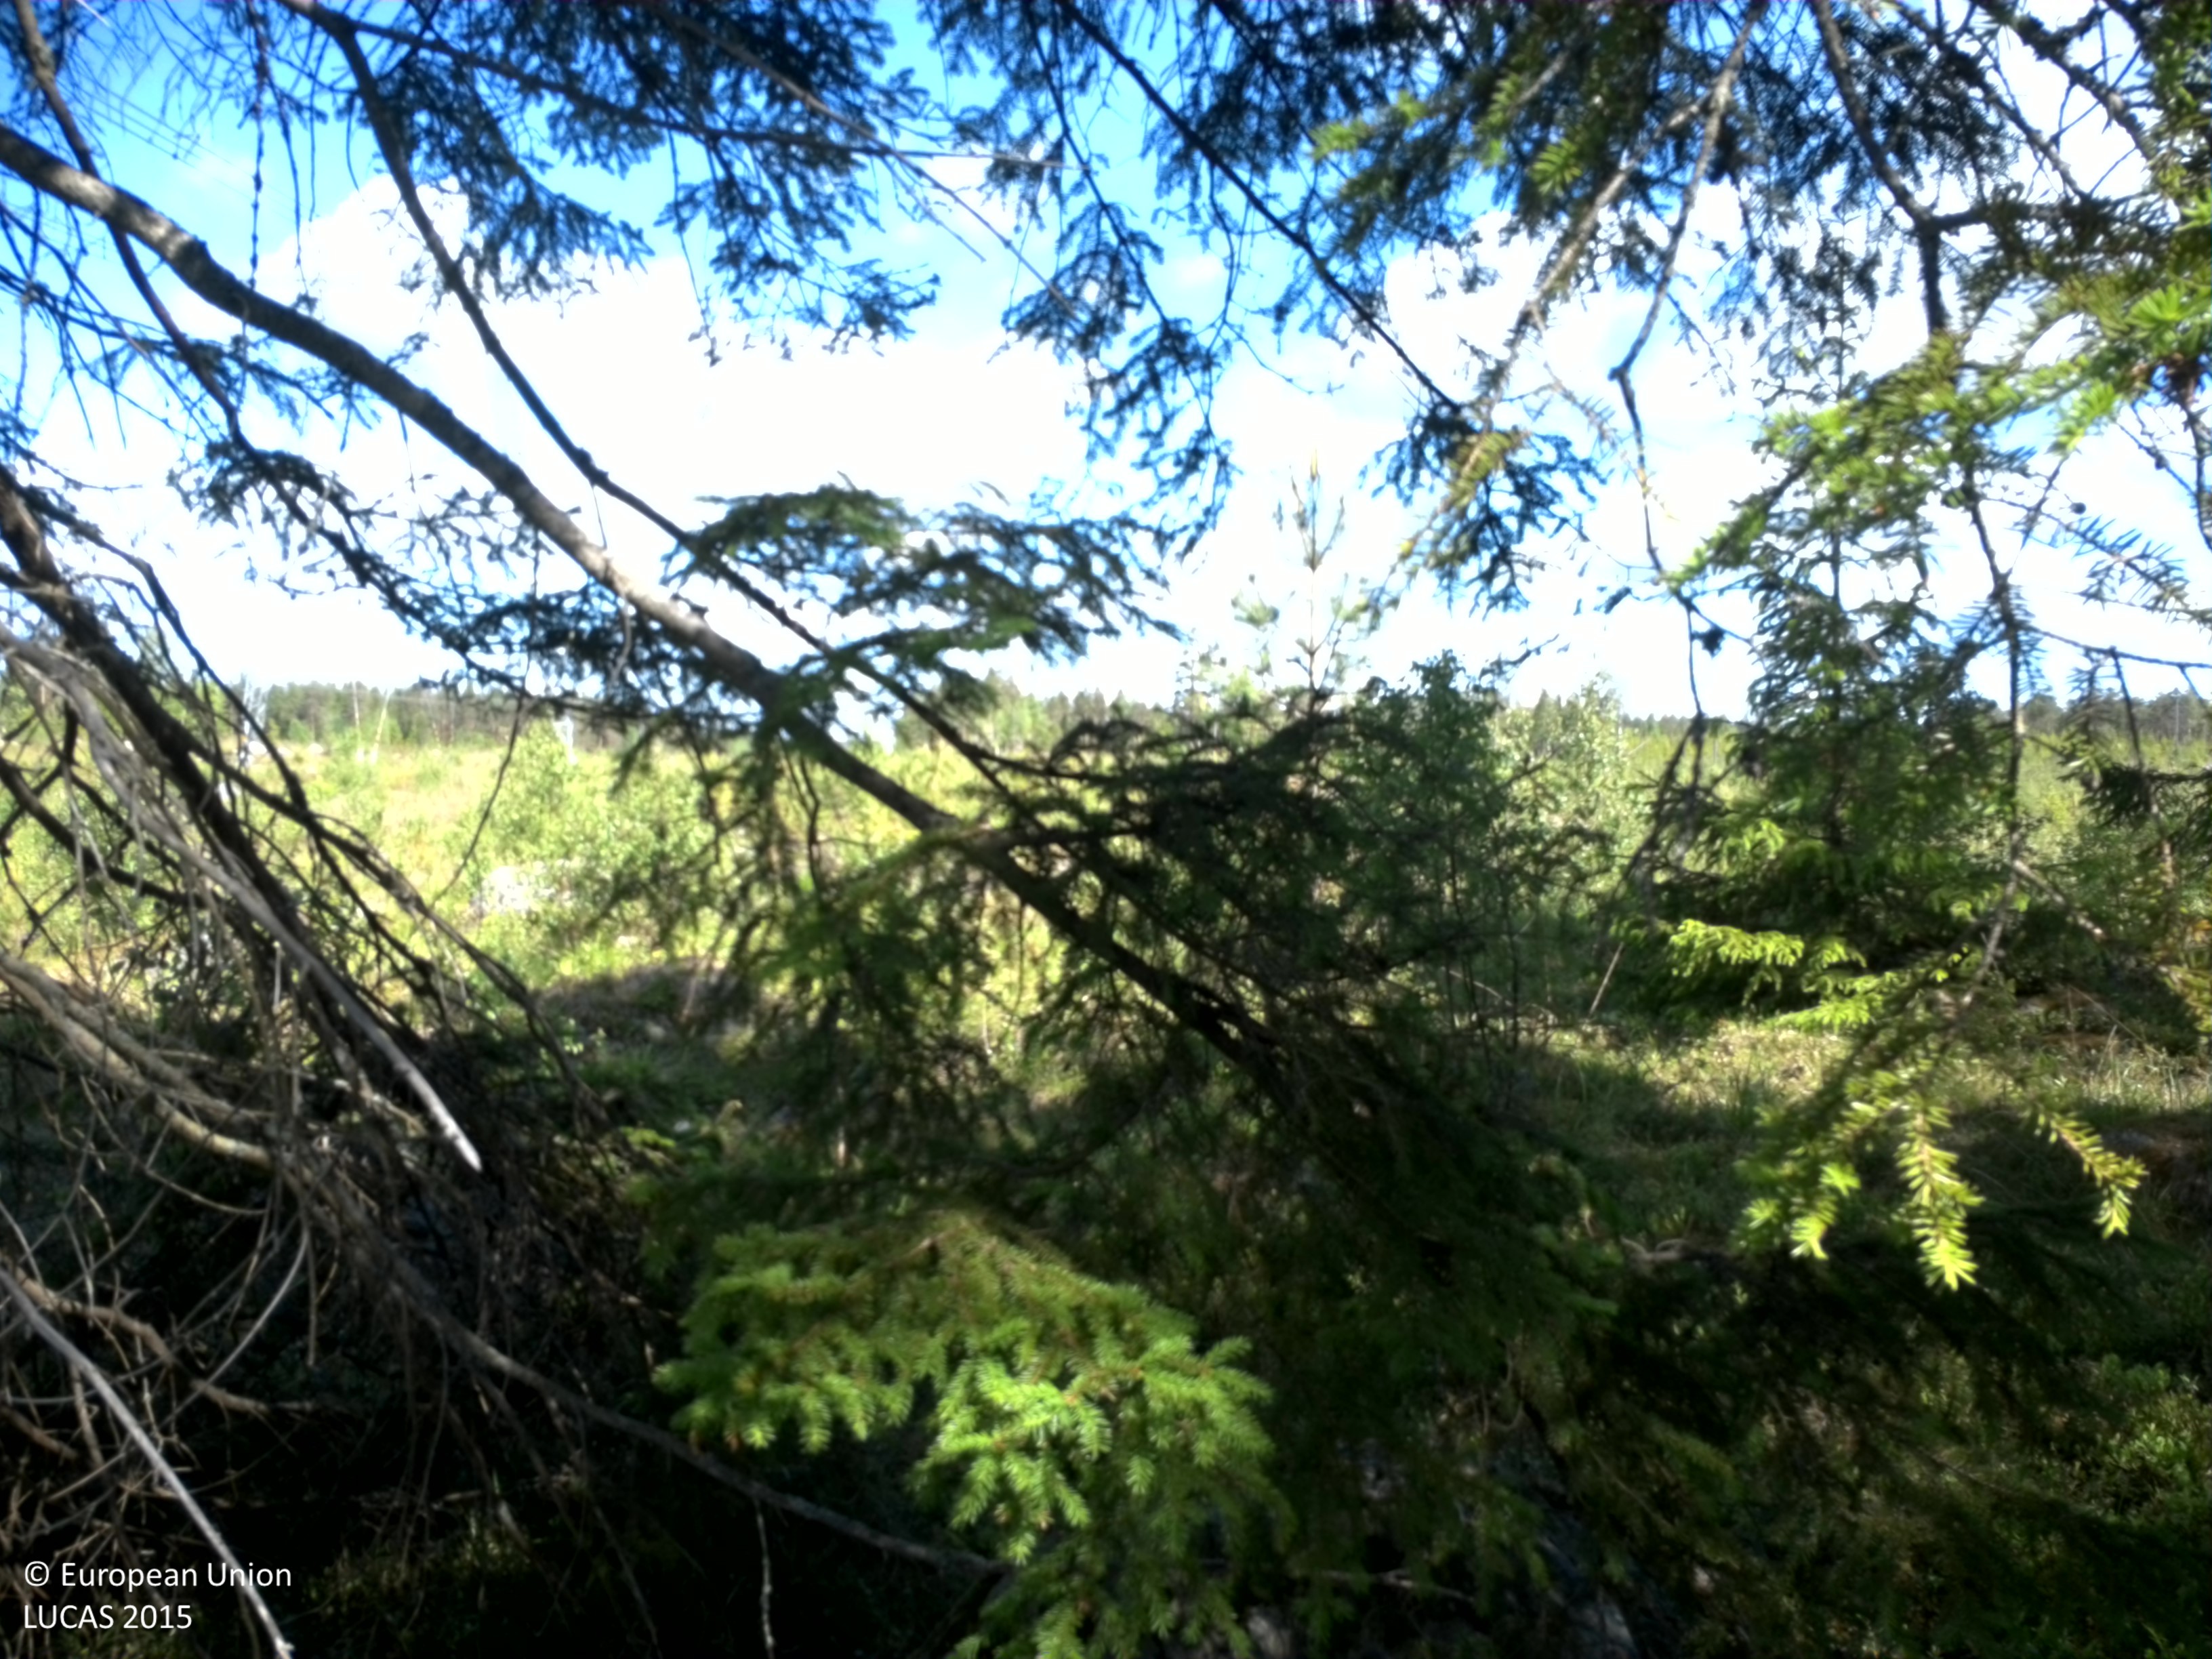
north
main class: Woodland
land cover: Spruce dominated mixed woodland
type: boreal forest
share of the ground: 50 - 75 %
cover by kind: coniferous forest trees 45 %, herbaceous plants 30 %, broadleaved forest trees 15 %, lichens and mosses 10 %
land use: Forestry
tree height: > 5 m
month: June
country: SE
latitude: 60.2554
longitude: 17.0922
